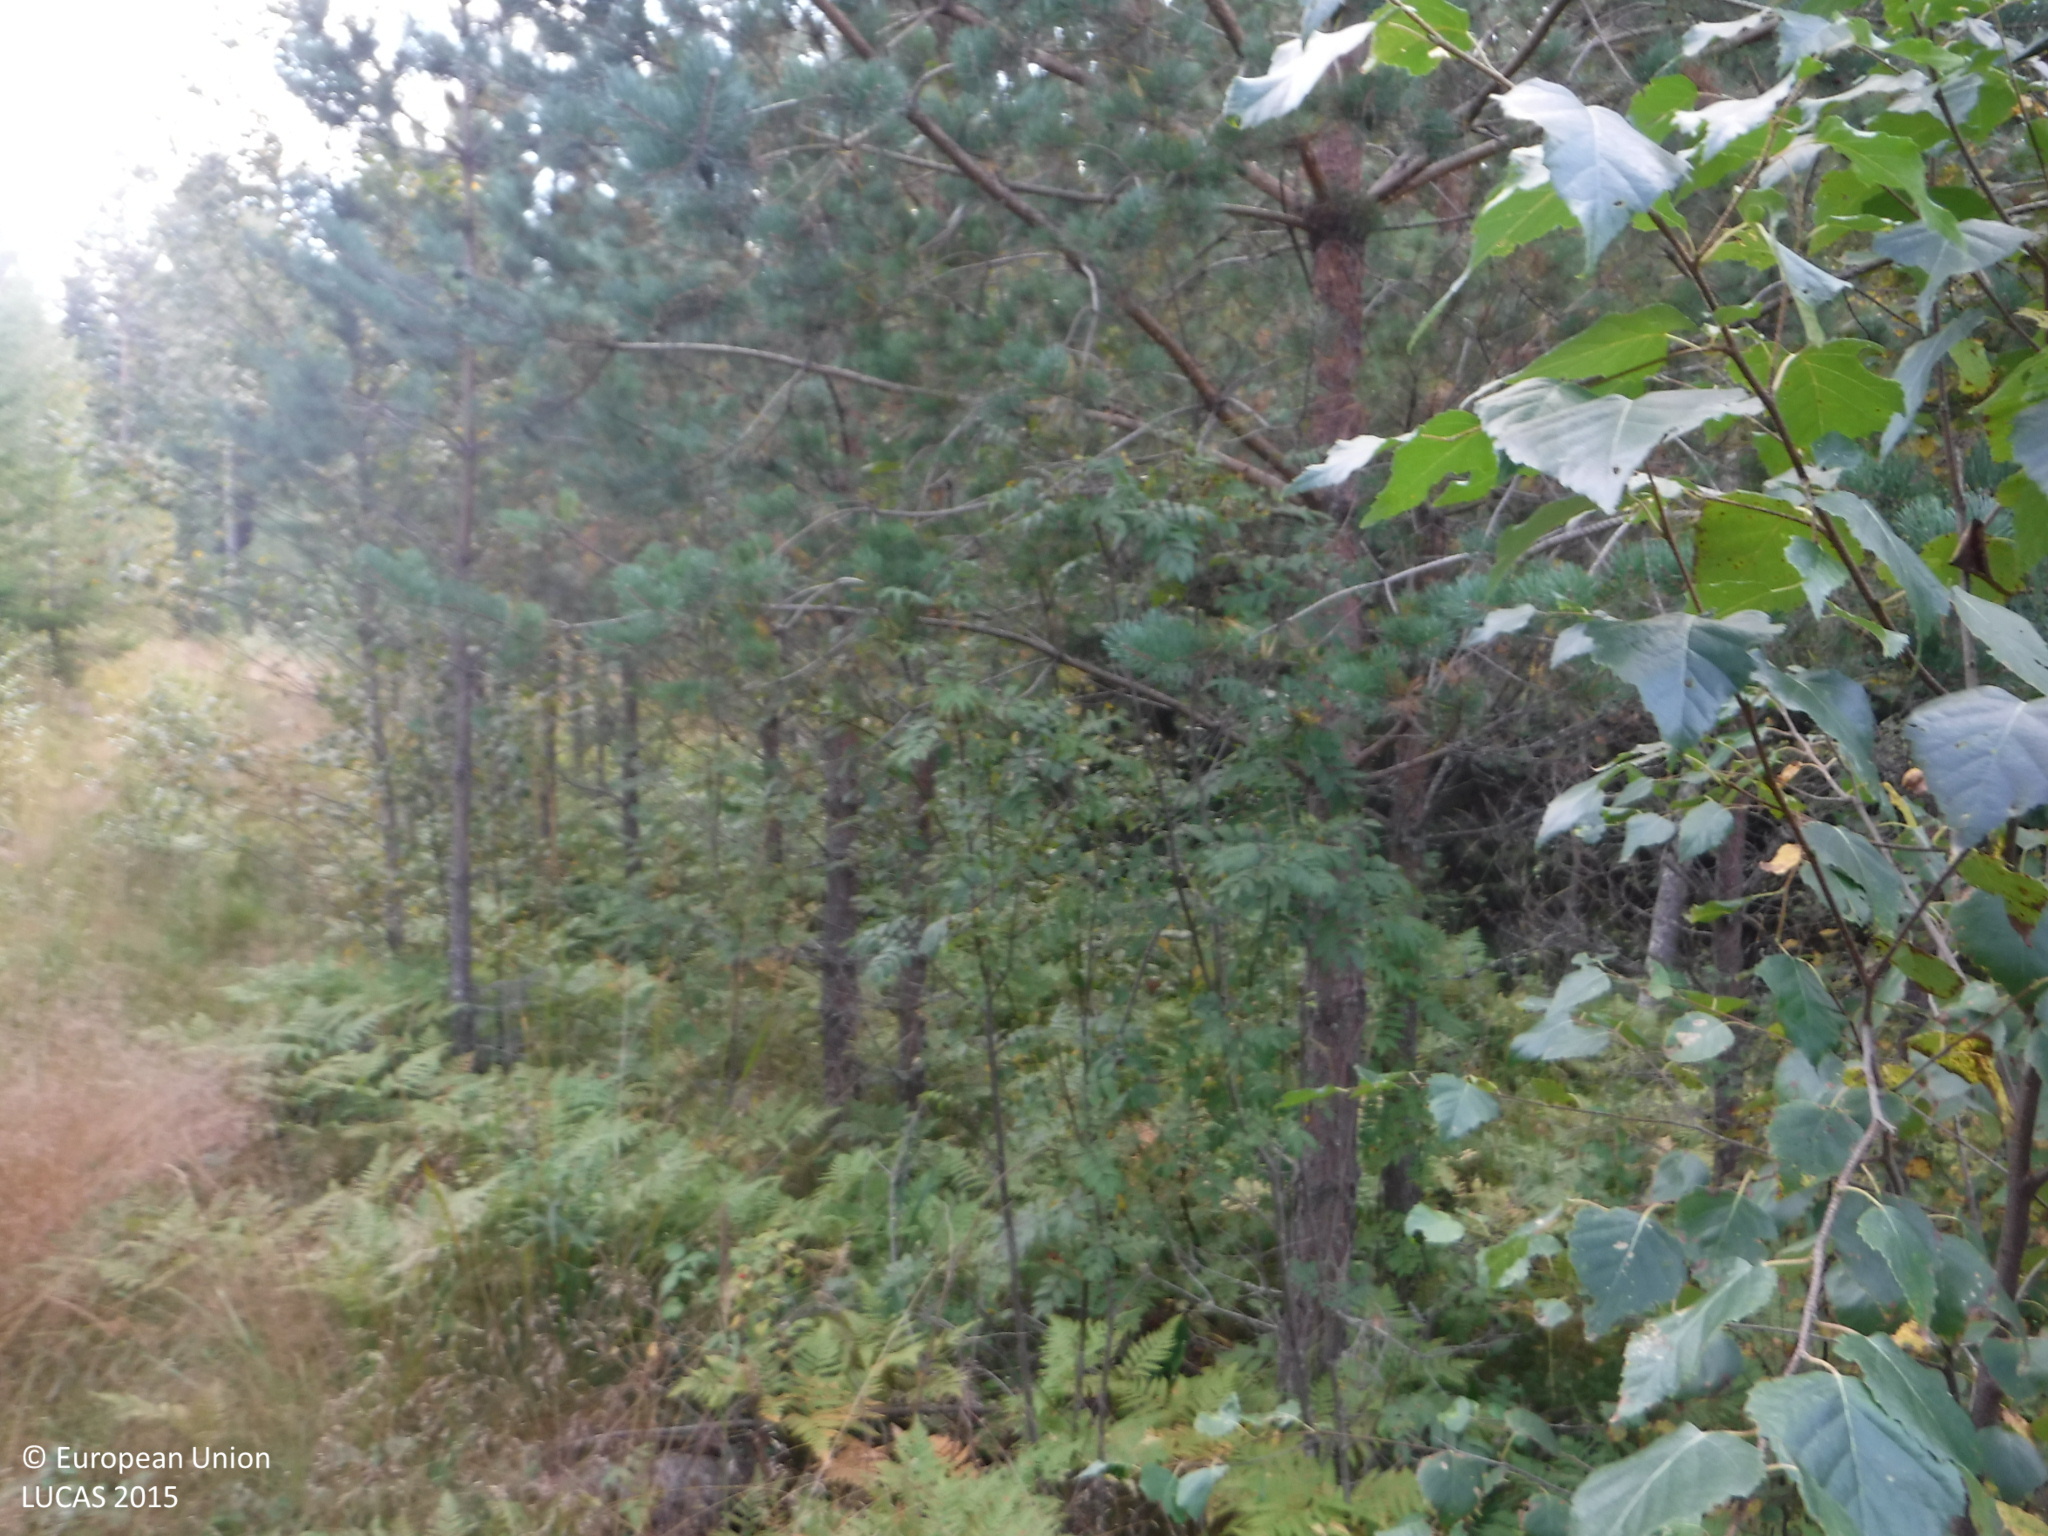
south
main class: Woodland
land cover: Pine dominated coniferous woodland
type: boreal forest
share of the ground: 50 - 75 %
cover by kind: coniferous forest trees 50 %, shrubs 35 %, lichens and mosses 10 %, herbaceous plants 5 %
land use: Forestry
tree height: > 5 m
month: August
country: FI
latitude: 61.2537
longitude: 21.7797
